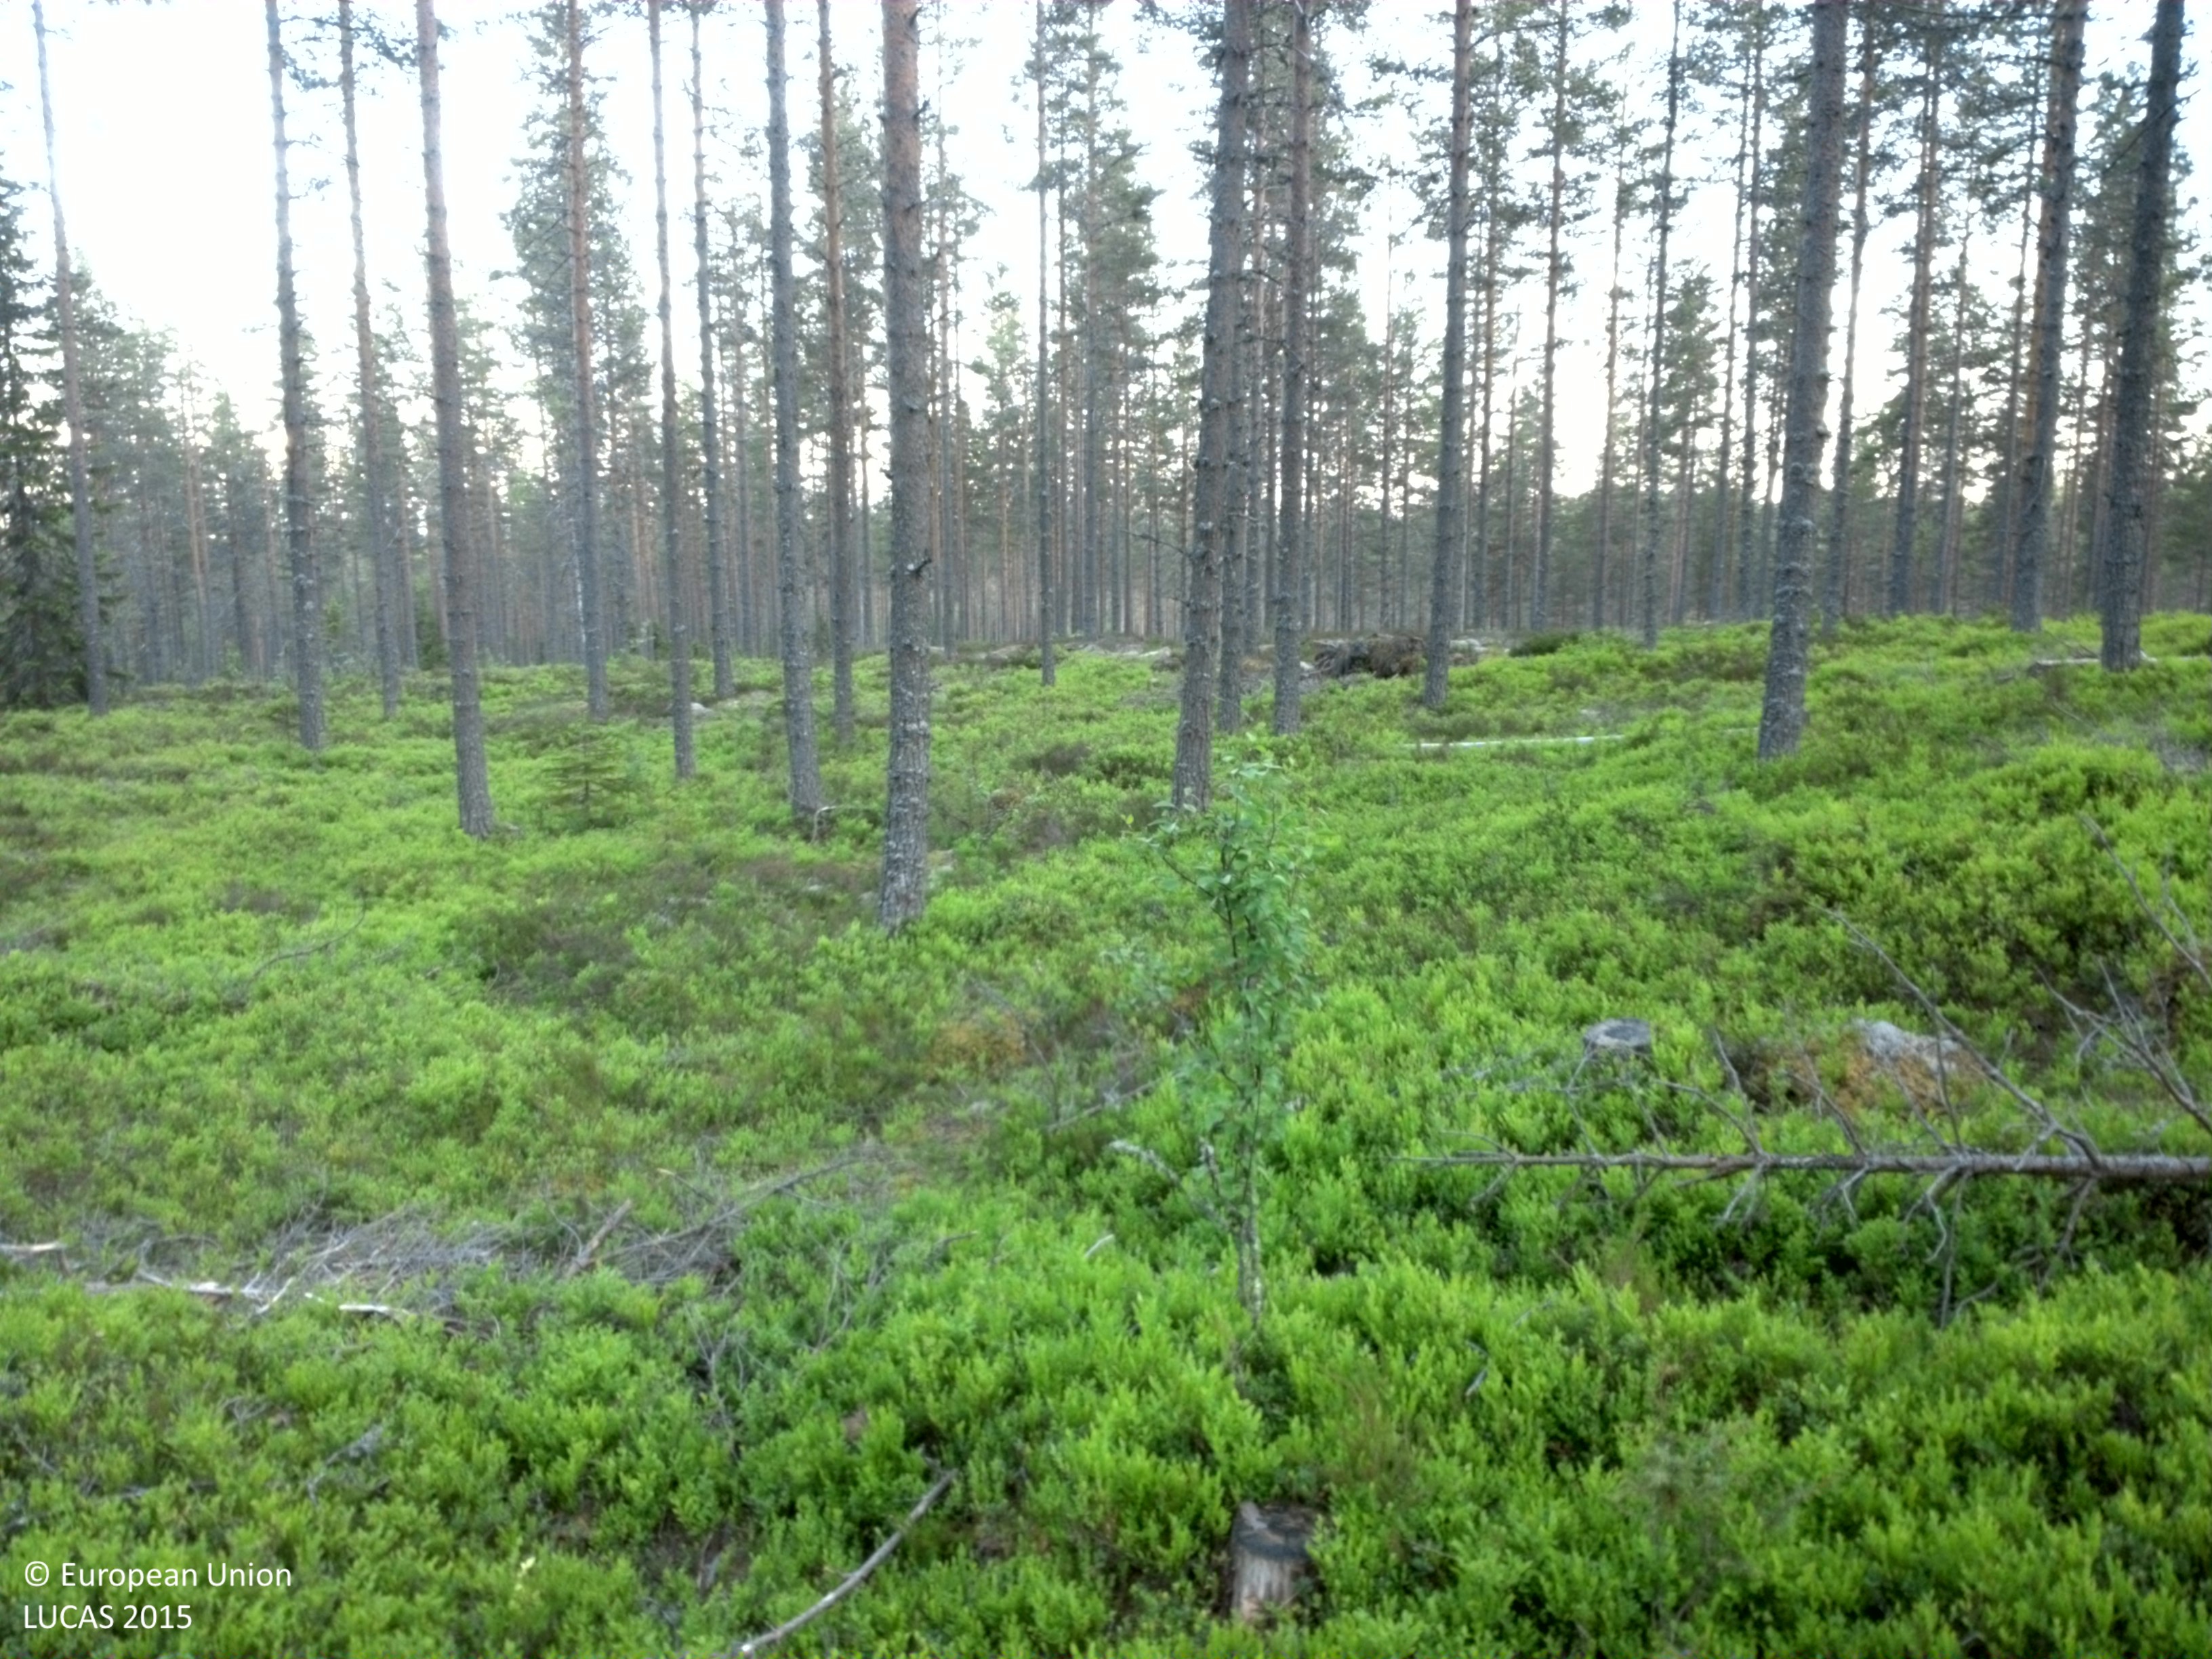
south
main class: Woodland
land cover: Pine dominated coniferous woodland
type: boreal forest
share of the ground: 10 - 25 %
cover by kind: shrubs 75 %, coniferous forest trees 20 %, lichens and mosses 5 %
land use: Forestry
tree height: > 5 m
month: June
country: SE
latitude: 60.7894
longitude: 12.4715
